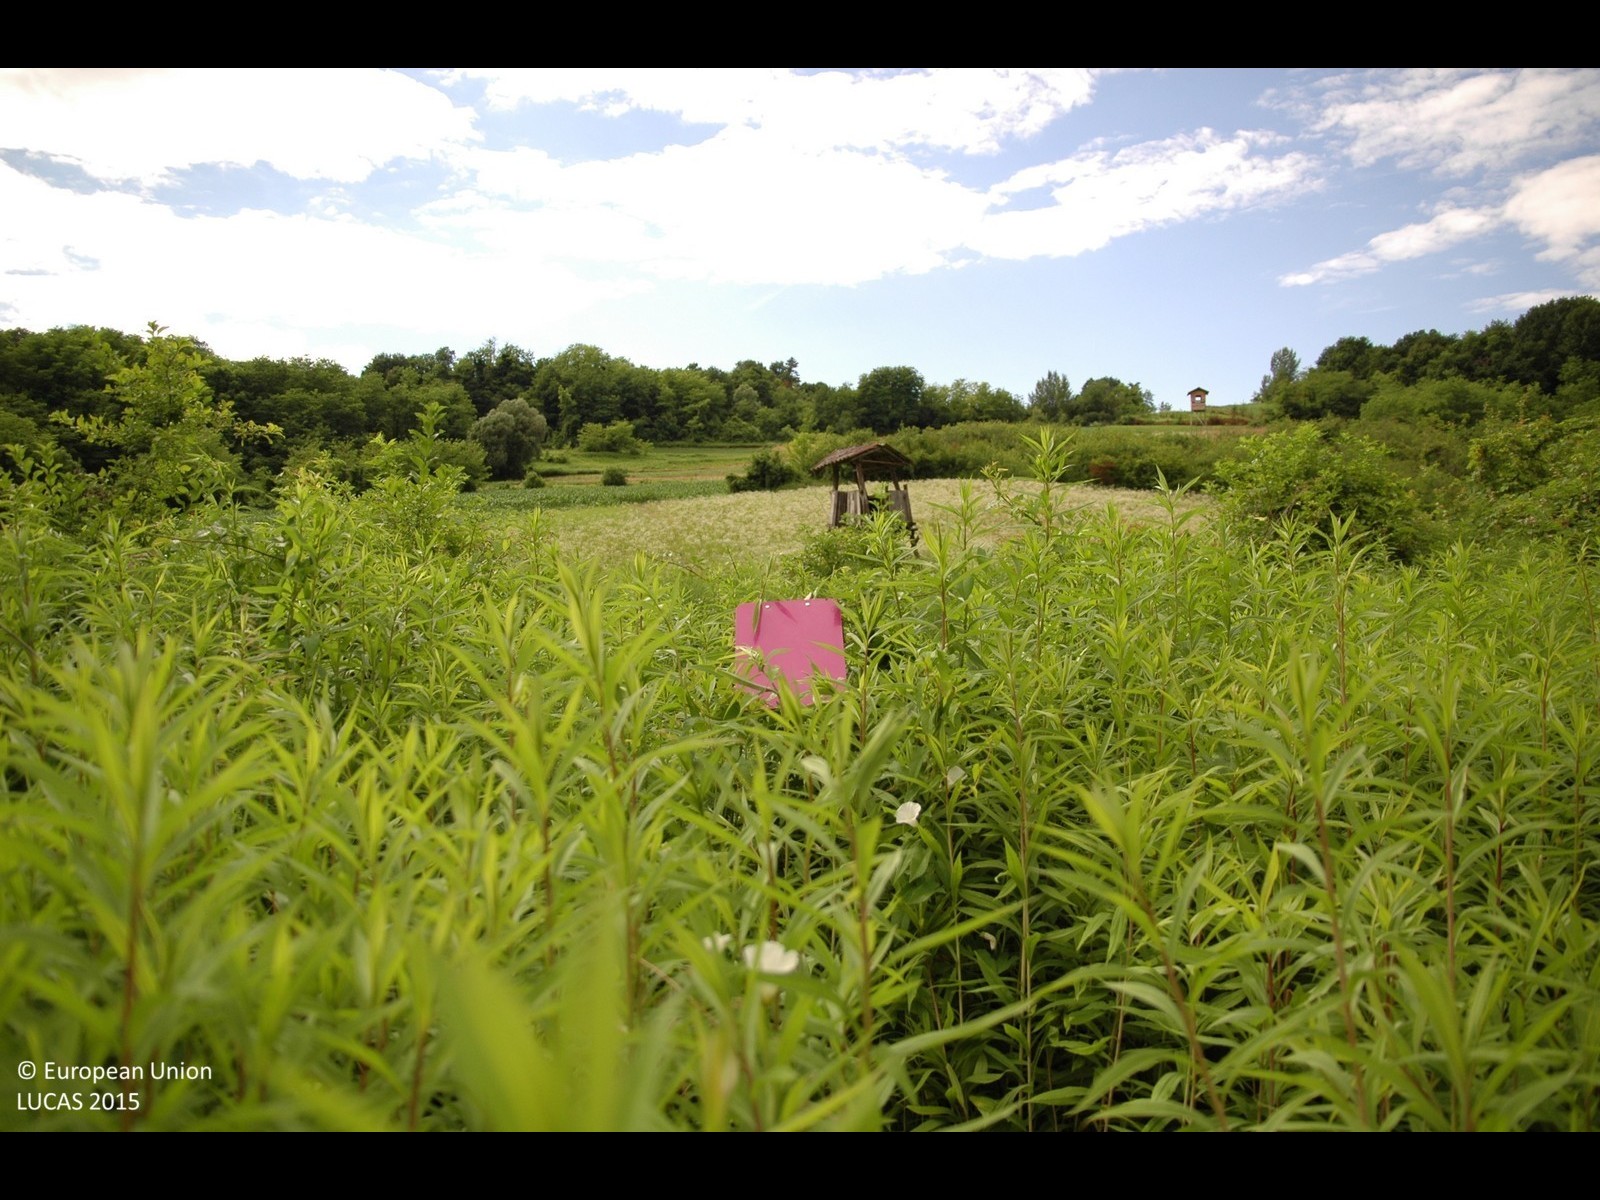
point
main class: Shrubland
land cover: Shrubland without tree cover
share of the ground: > 75 %
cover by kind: shrubs 90 %, herbaceous plants 10 %
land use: Fallow land
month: June
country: HR
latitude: 46.0630
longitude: 15.8802
